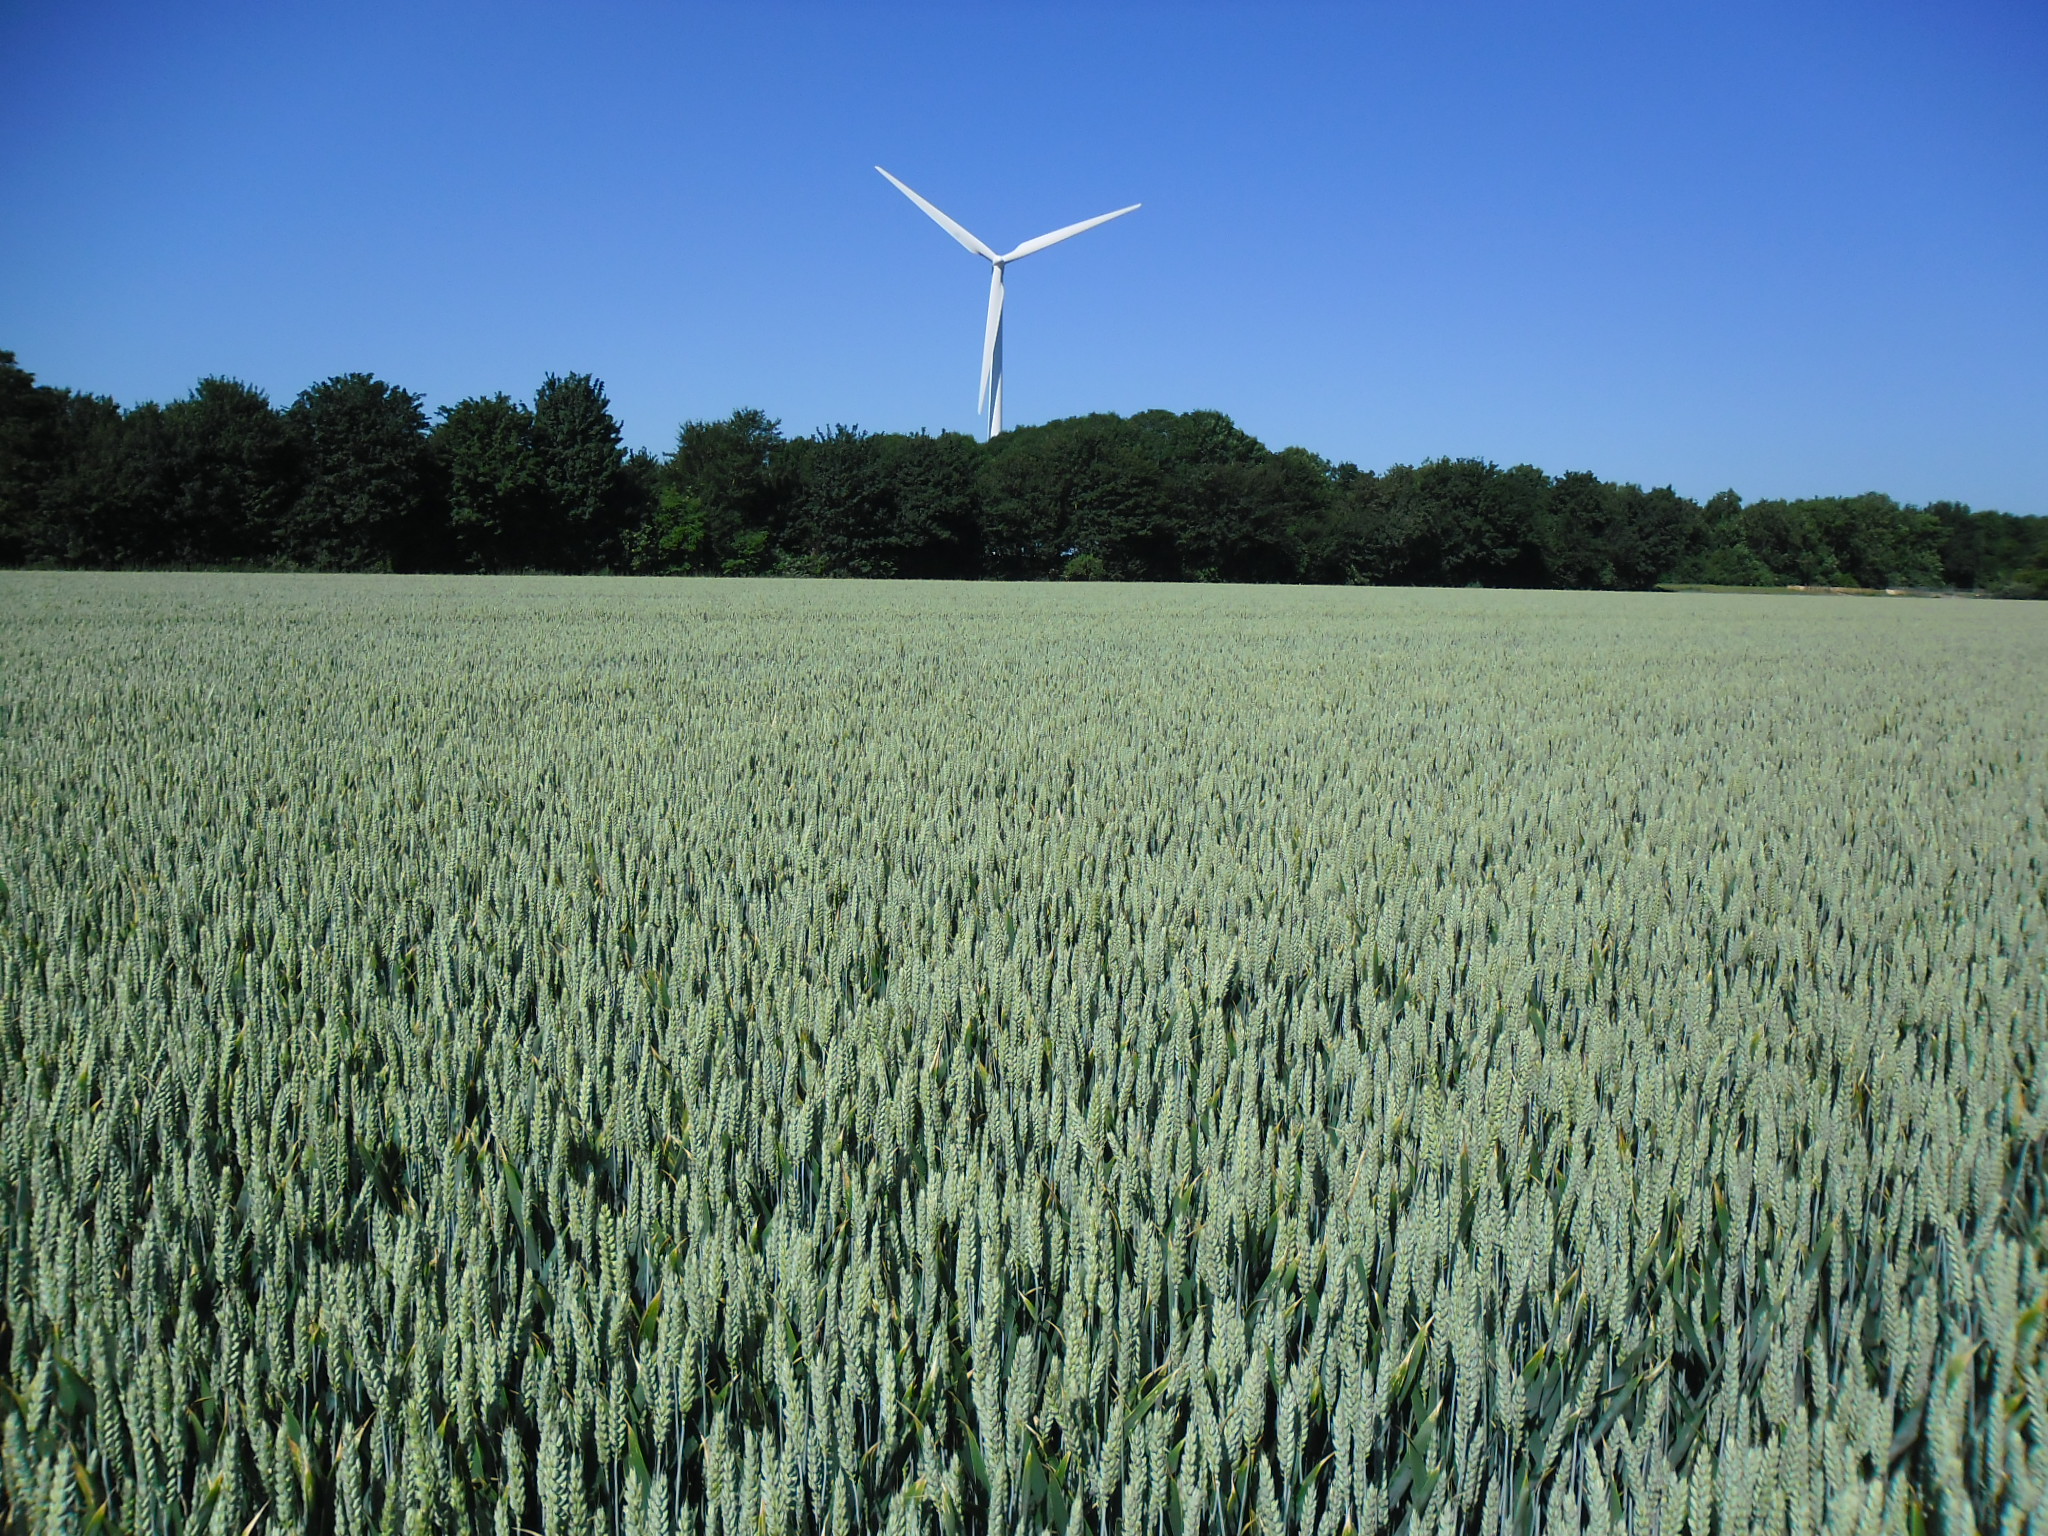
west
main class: Cropland
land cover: Common wheat
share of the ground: > 75 %
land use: Agriculture (excluding fallow land and kitchen gardens)
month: June
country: NL
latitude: 52.4165
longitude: 5.4551
